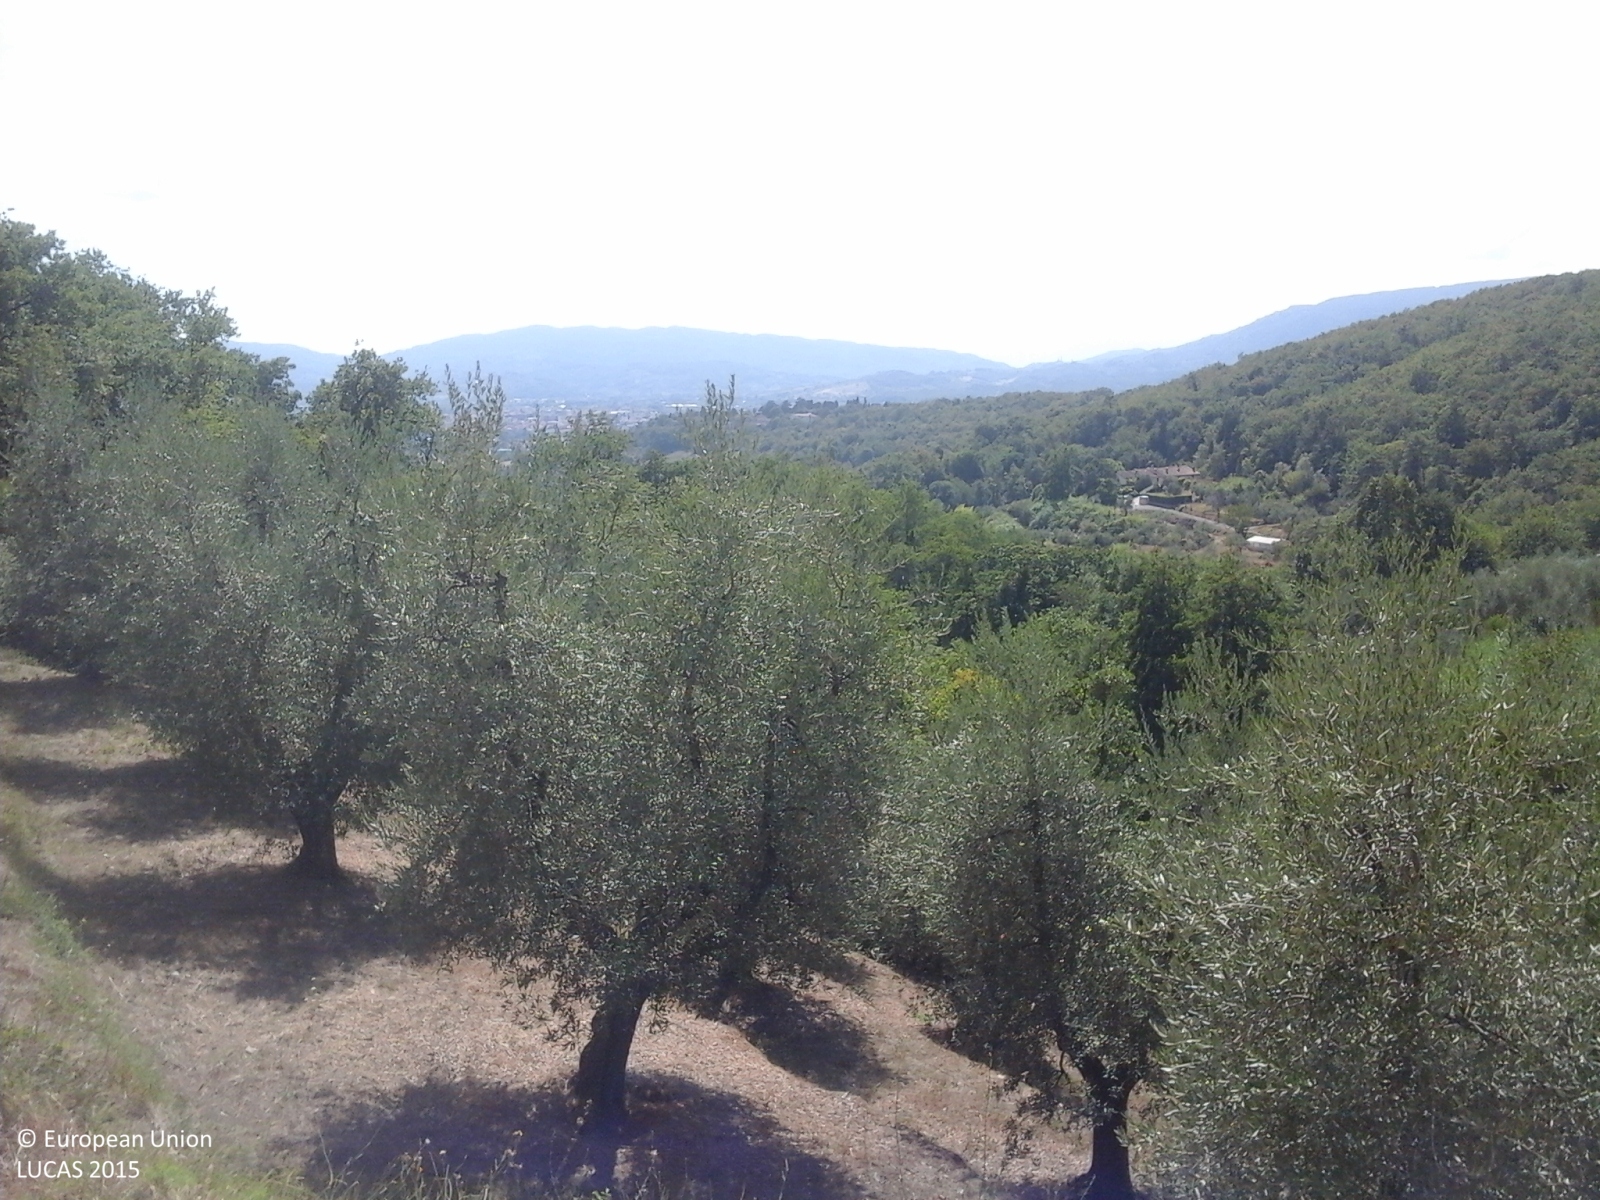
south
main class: Cropland
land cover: Olive groves
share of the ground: 25 - 50 %
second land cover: Grassland without tree/shrub cover
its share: > 75 %
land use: Agriculture (excluding fallow land and kitchen gardens)
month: August
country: IT
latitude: 43.9675
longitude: 10.9325
